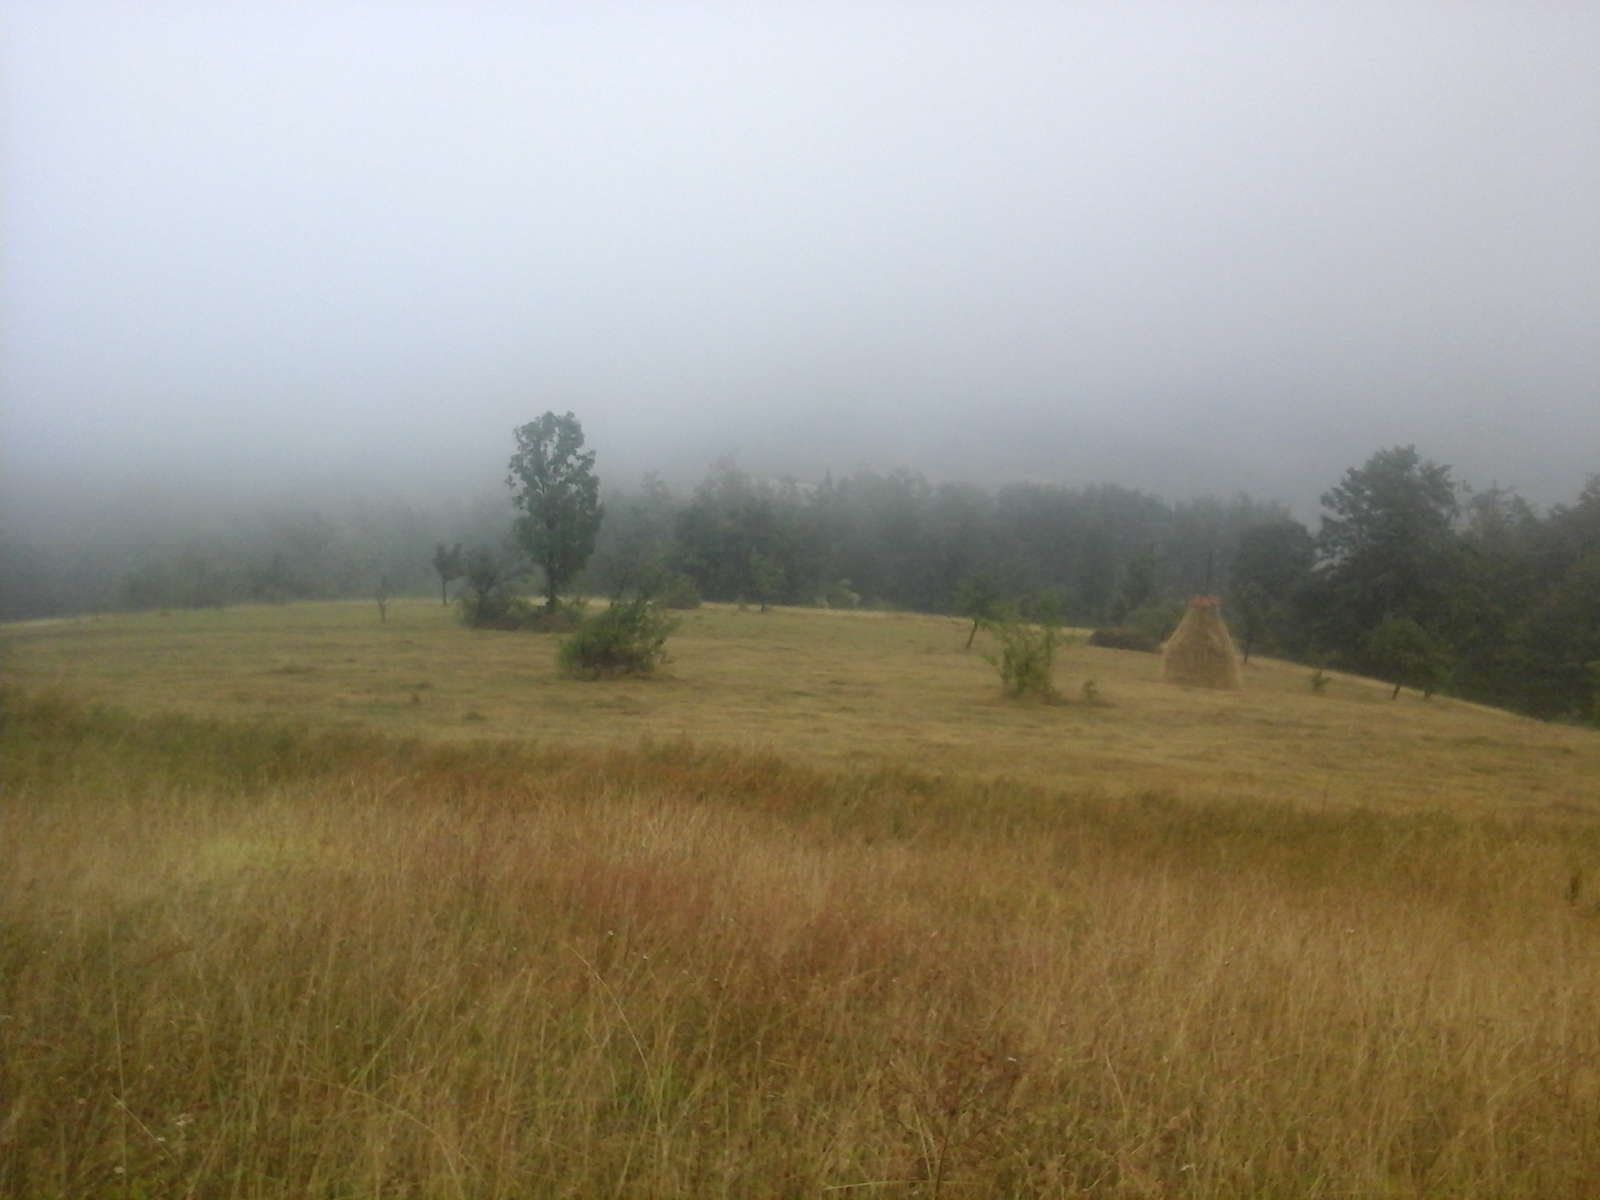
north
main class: Grassland
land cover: Grassland without tree/shrub cover
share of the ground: > 75 %
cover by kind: herbaceous plants 100 %
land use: Agriculture (excluding fallow land and kitchen gardens)
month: August
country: RO
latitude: 45.0111
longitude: 22.6693
